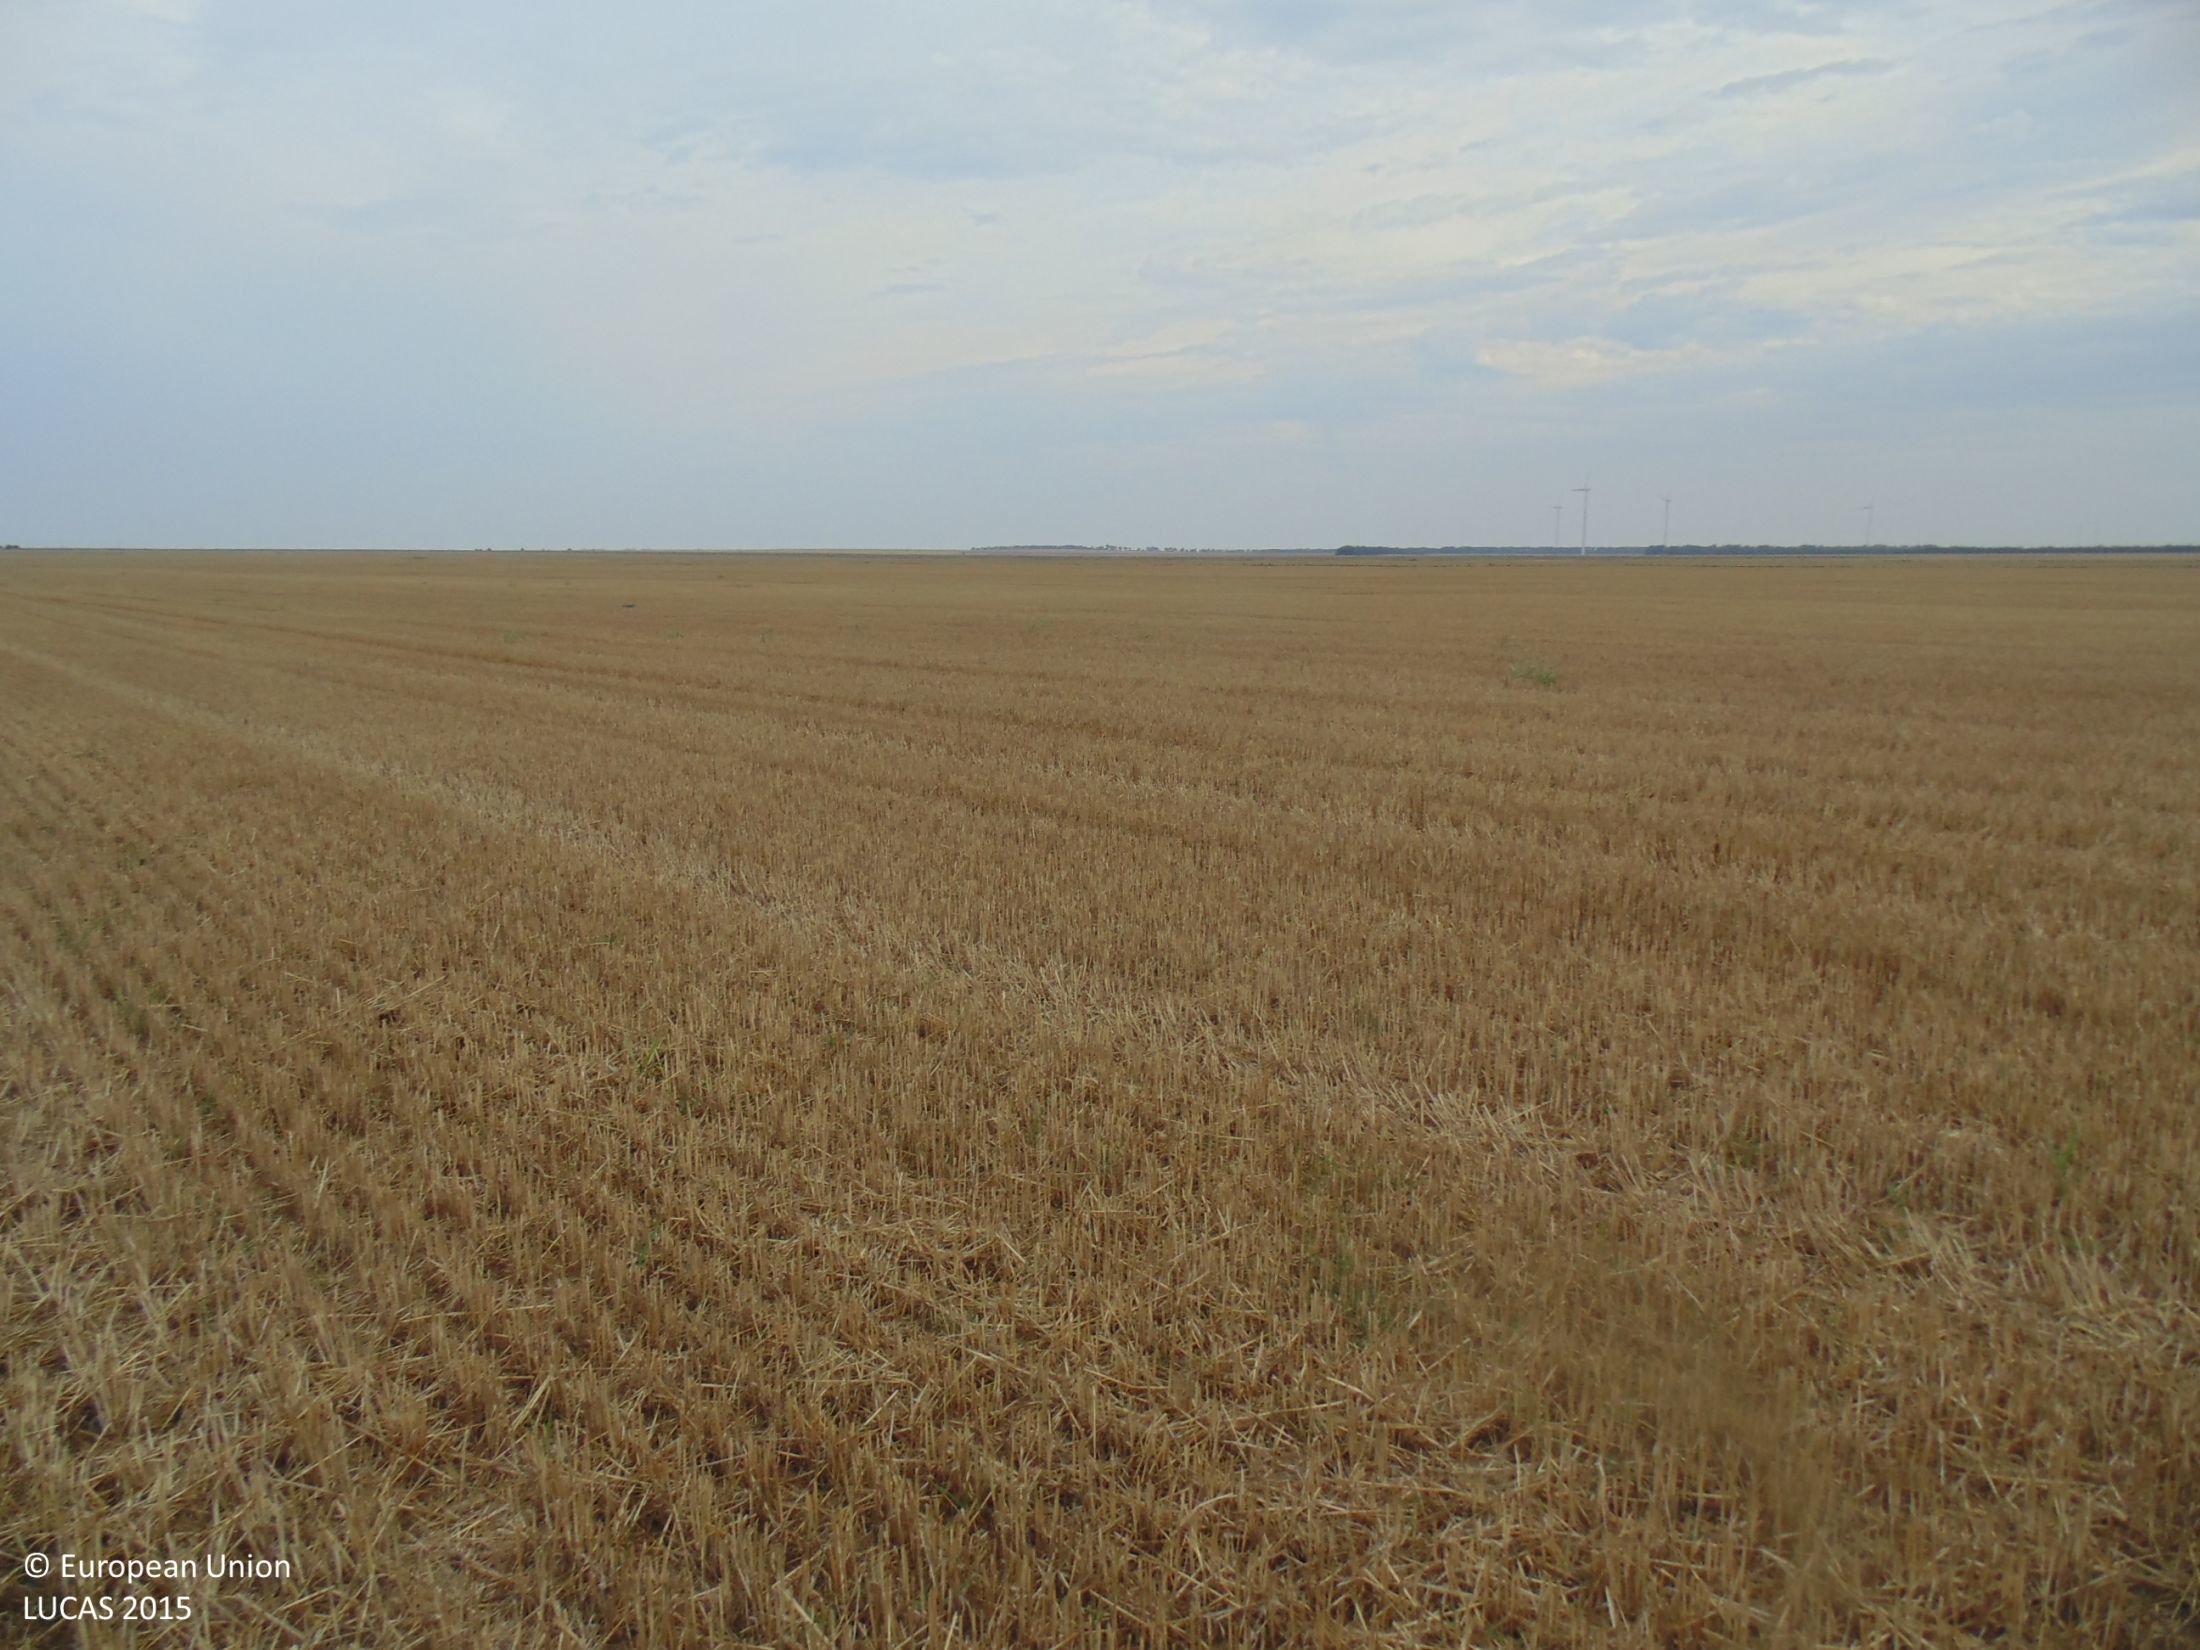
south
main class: Cropland
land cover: Common wheat
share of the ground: 50 - 75 %
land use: Agriculture (excluding fallow land and kitchen gardens)
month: August
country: BG
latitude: 43.5084
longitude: 28.5559
